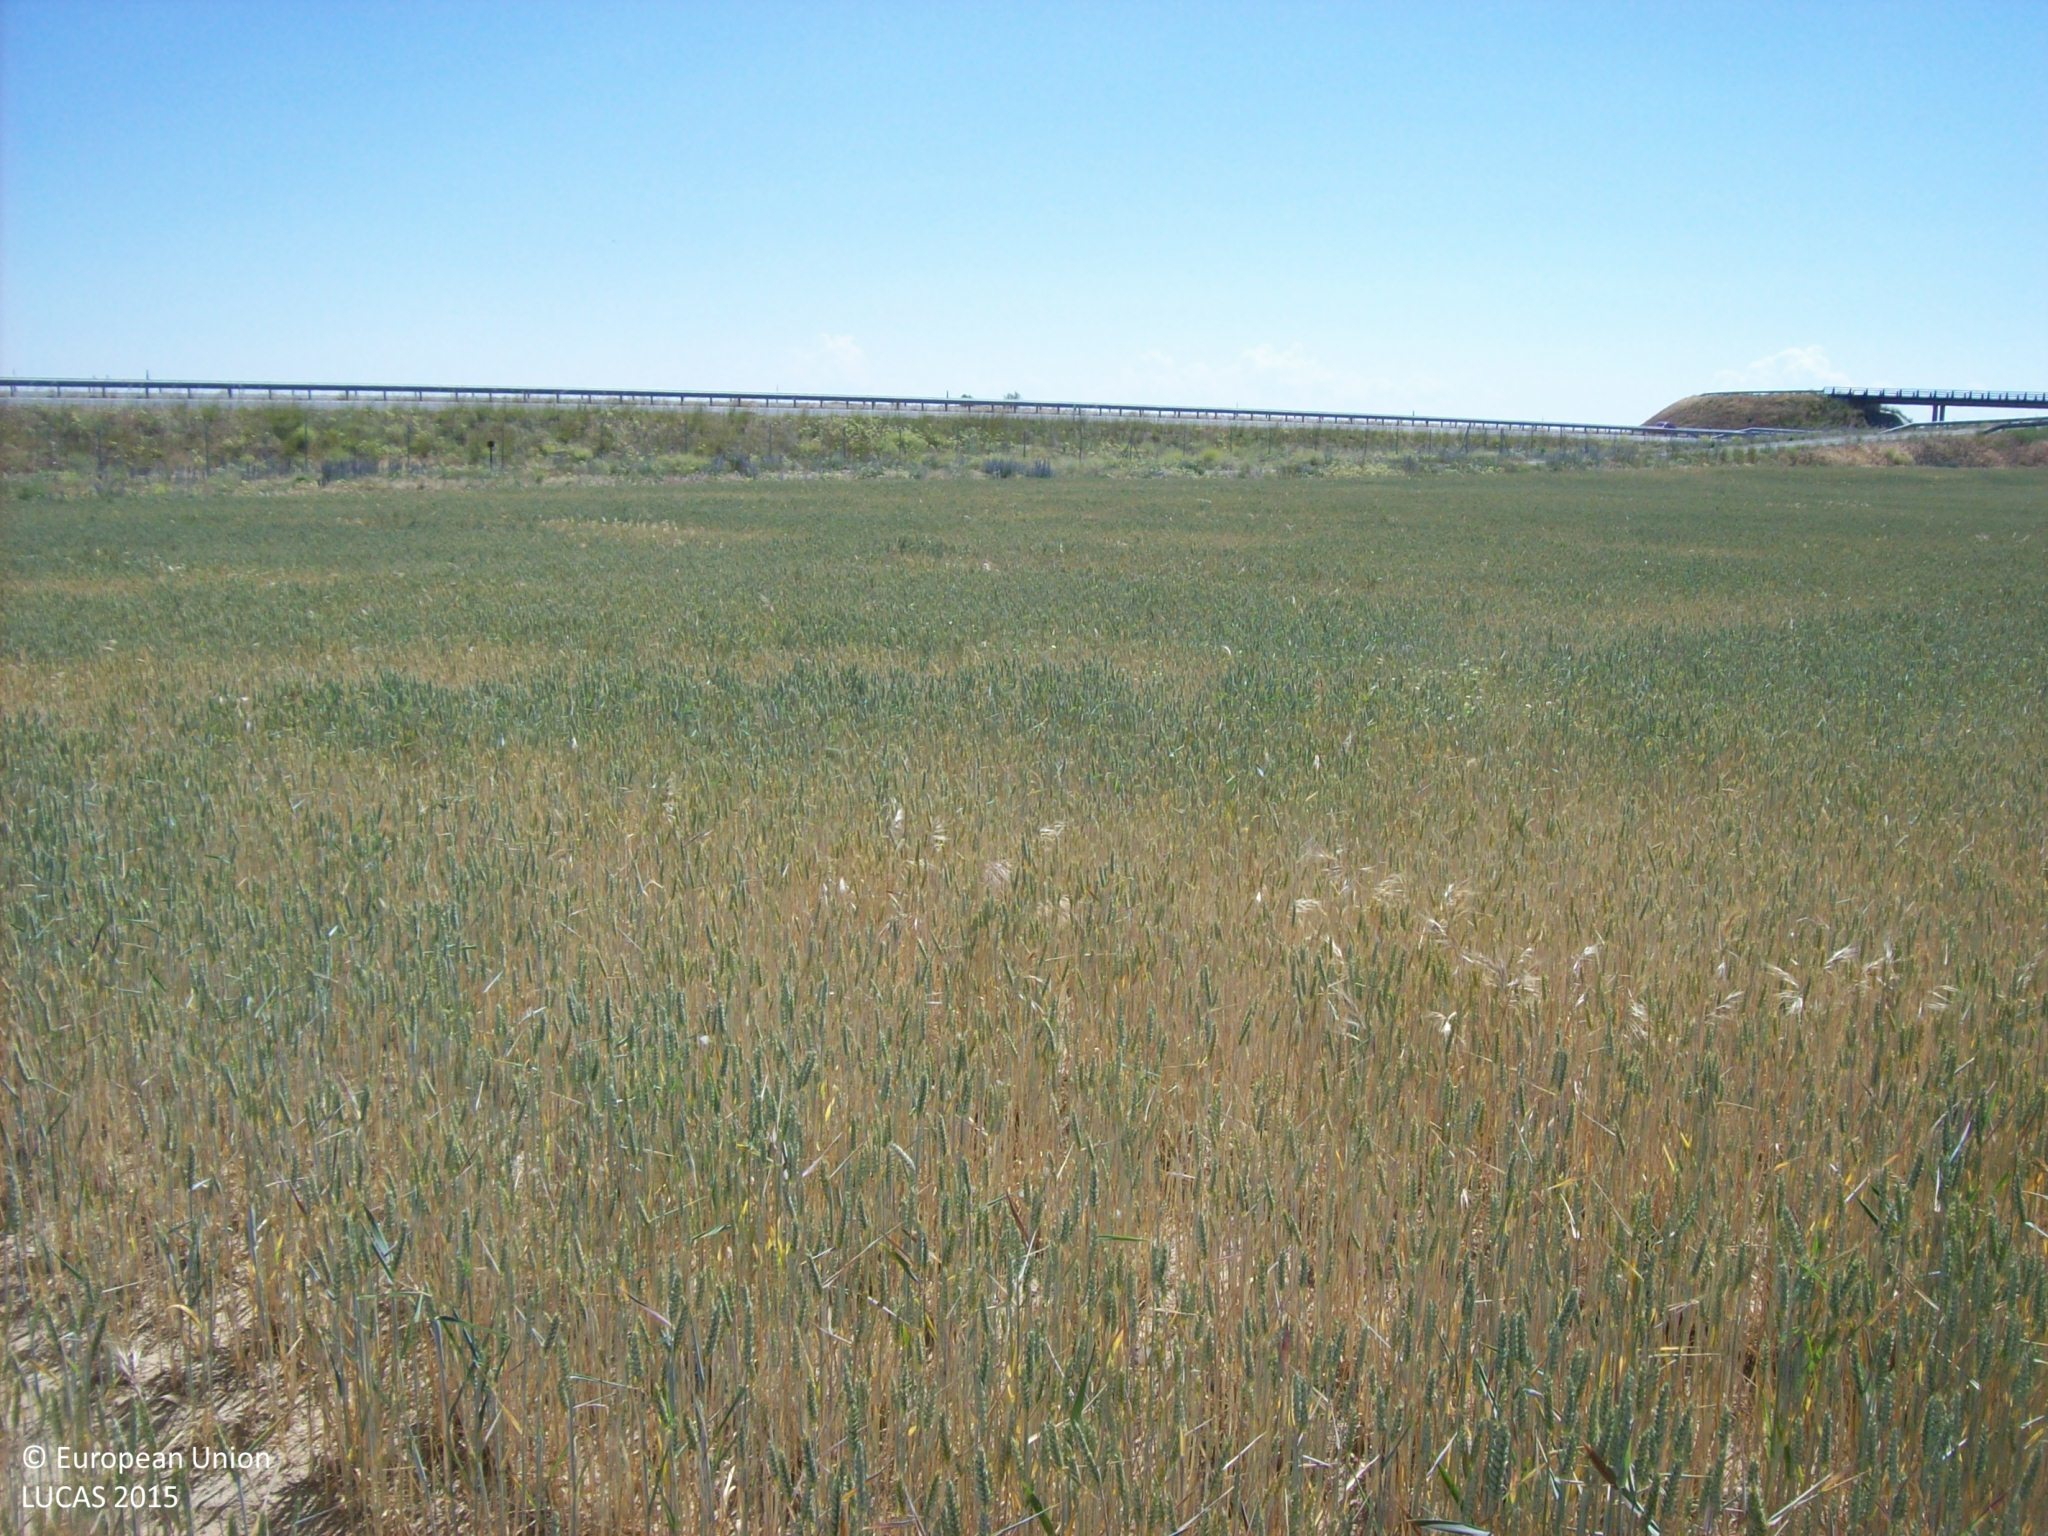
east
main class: Cropland
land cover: Common wheat
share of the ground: > 75 %
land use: Agriculture (excluding fallow land and kitchen gardens)
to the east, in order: Common wheat; Grass margins; Tracks; Grass margins; Fences; Grassland without tree/shrub cover; Paved roads, cycling and walking lanes; Grassland without tree/shrub cover; Ditches and canals; Grassland without tree/shrub cover; Paved roads, cycling and walking lanes; Grassland without tree/shrub cover; Fences; Grass margins; Common wheat
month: May
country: ES
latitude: 40.8867
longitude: -5.0060
